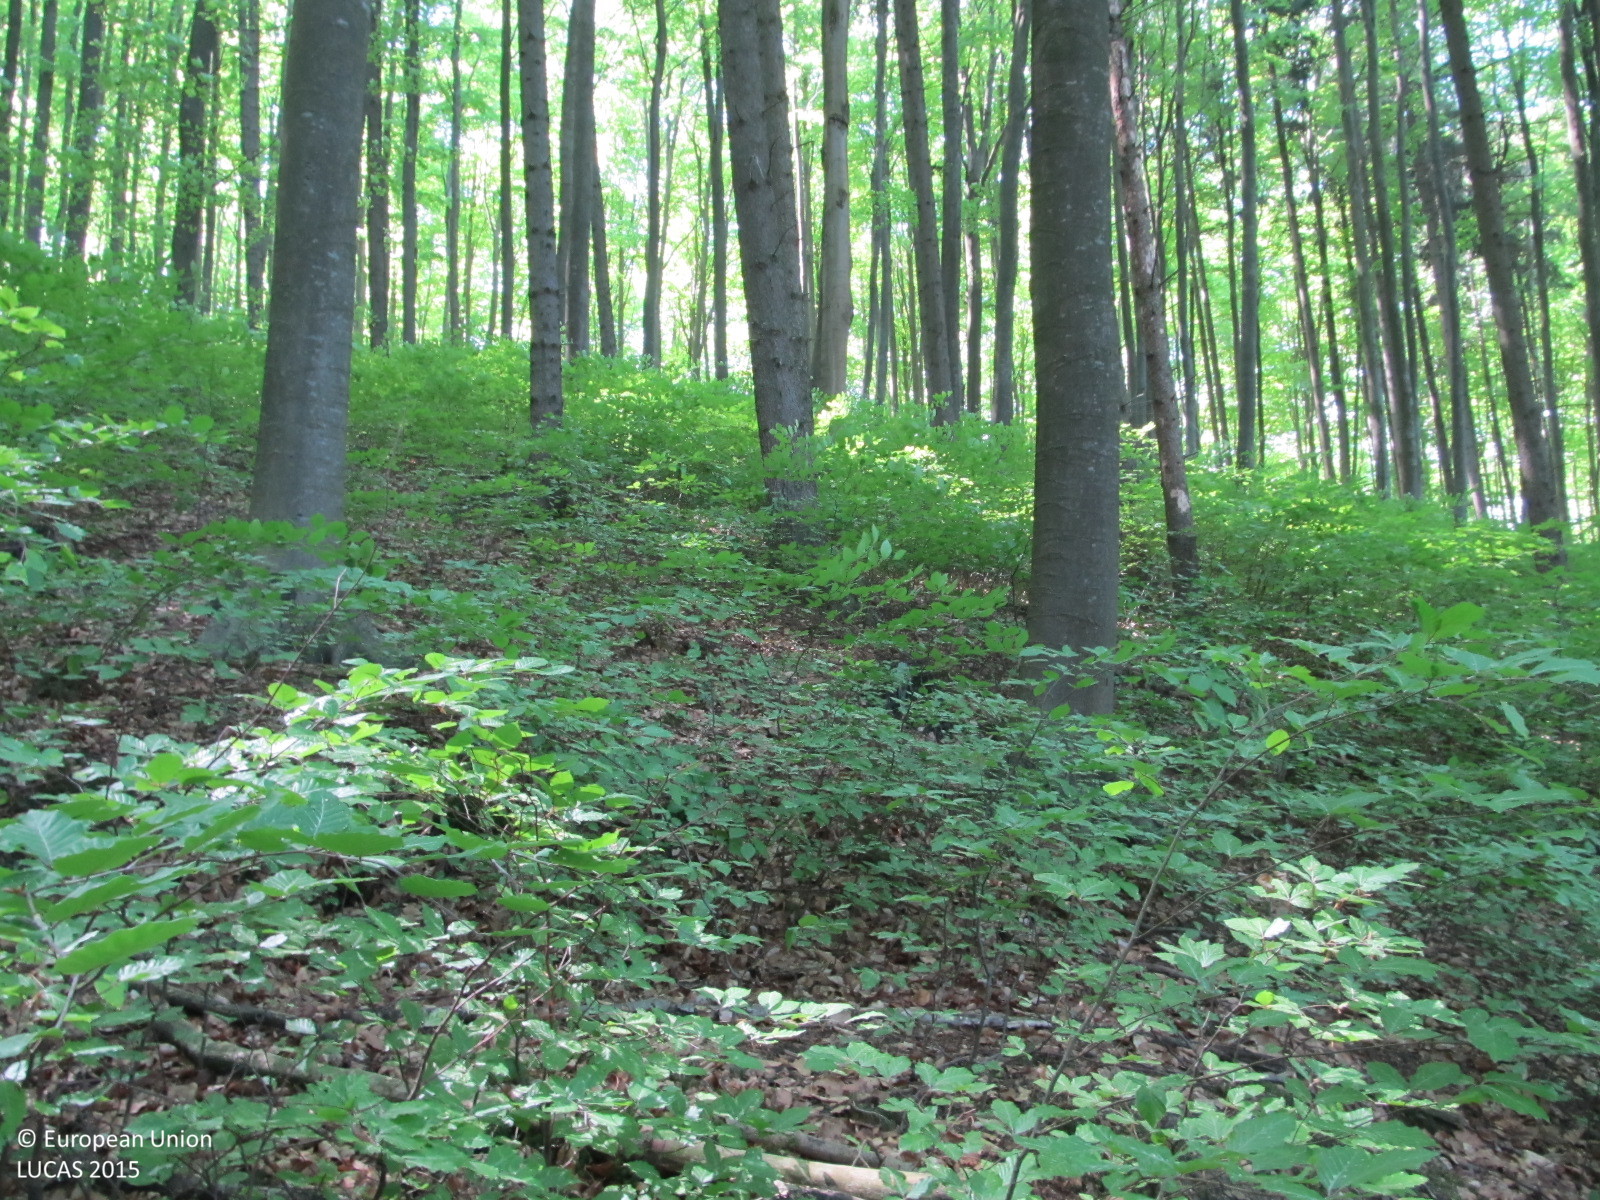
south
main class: Woodland
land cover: Broadleaved woodland
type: beech forest
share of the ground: > 75 %
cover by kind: broadleaved forest trees 60 %, coniferous forest trees 20 %, shrubs 10 %, unconsolidated bare surface 10 %
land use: Forestry
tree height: > 5 m
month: May
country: AT
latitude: 48.6081
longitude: 15.5229
